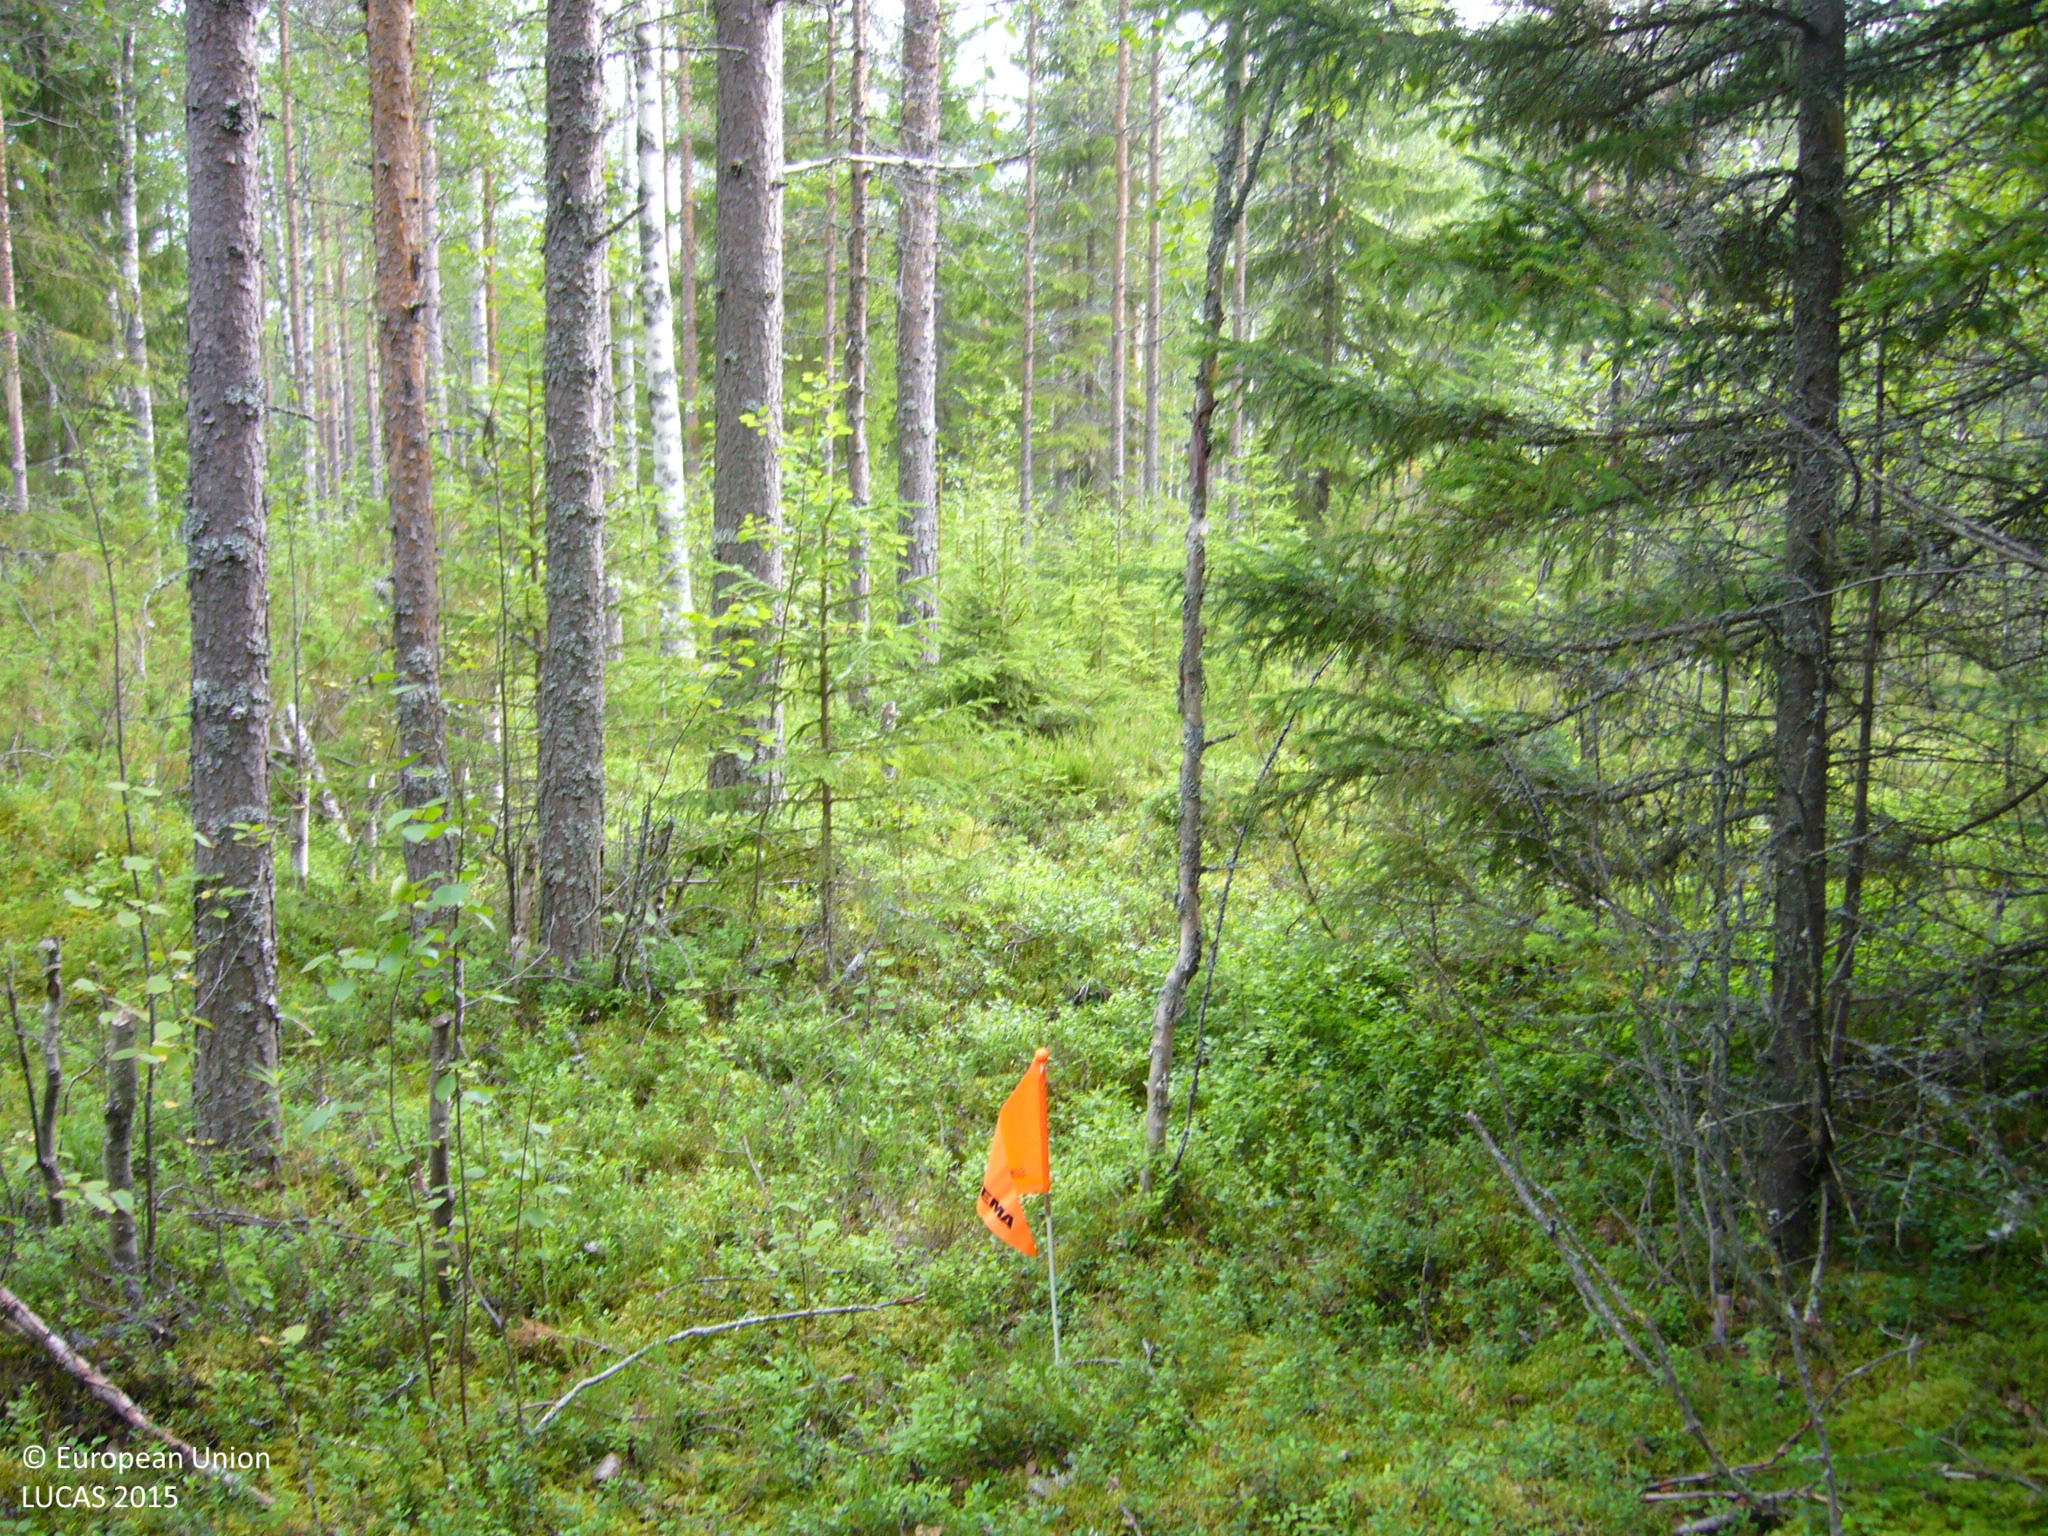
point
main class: Woodland
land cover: Pine dominated mixed woodland
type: boreal forest
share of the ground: > 75 %
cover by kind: coniferous forest trees 40 %, broadleaved forest trees 35 %, shrubs 25 %
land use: Forestry
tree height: > 5 m
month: July
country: FI
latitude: 63.9640
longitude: 26.7286
